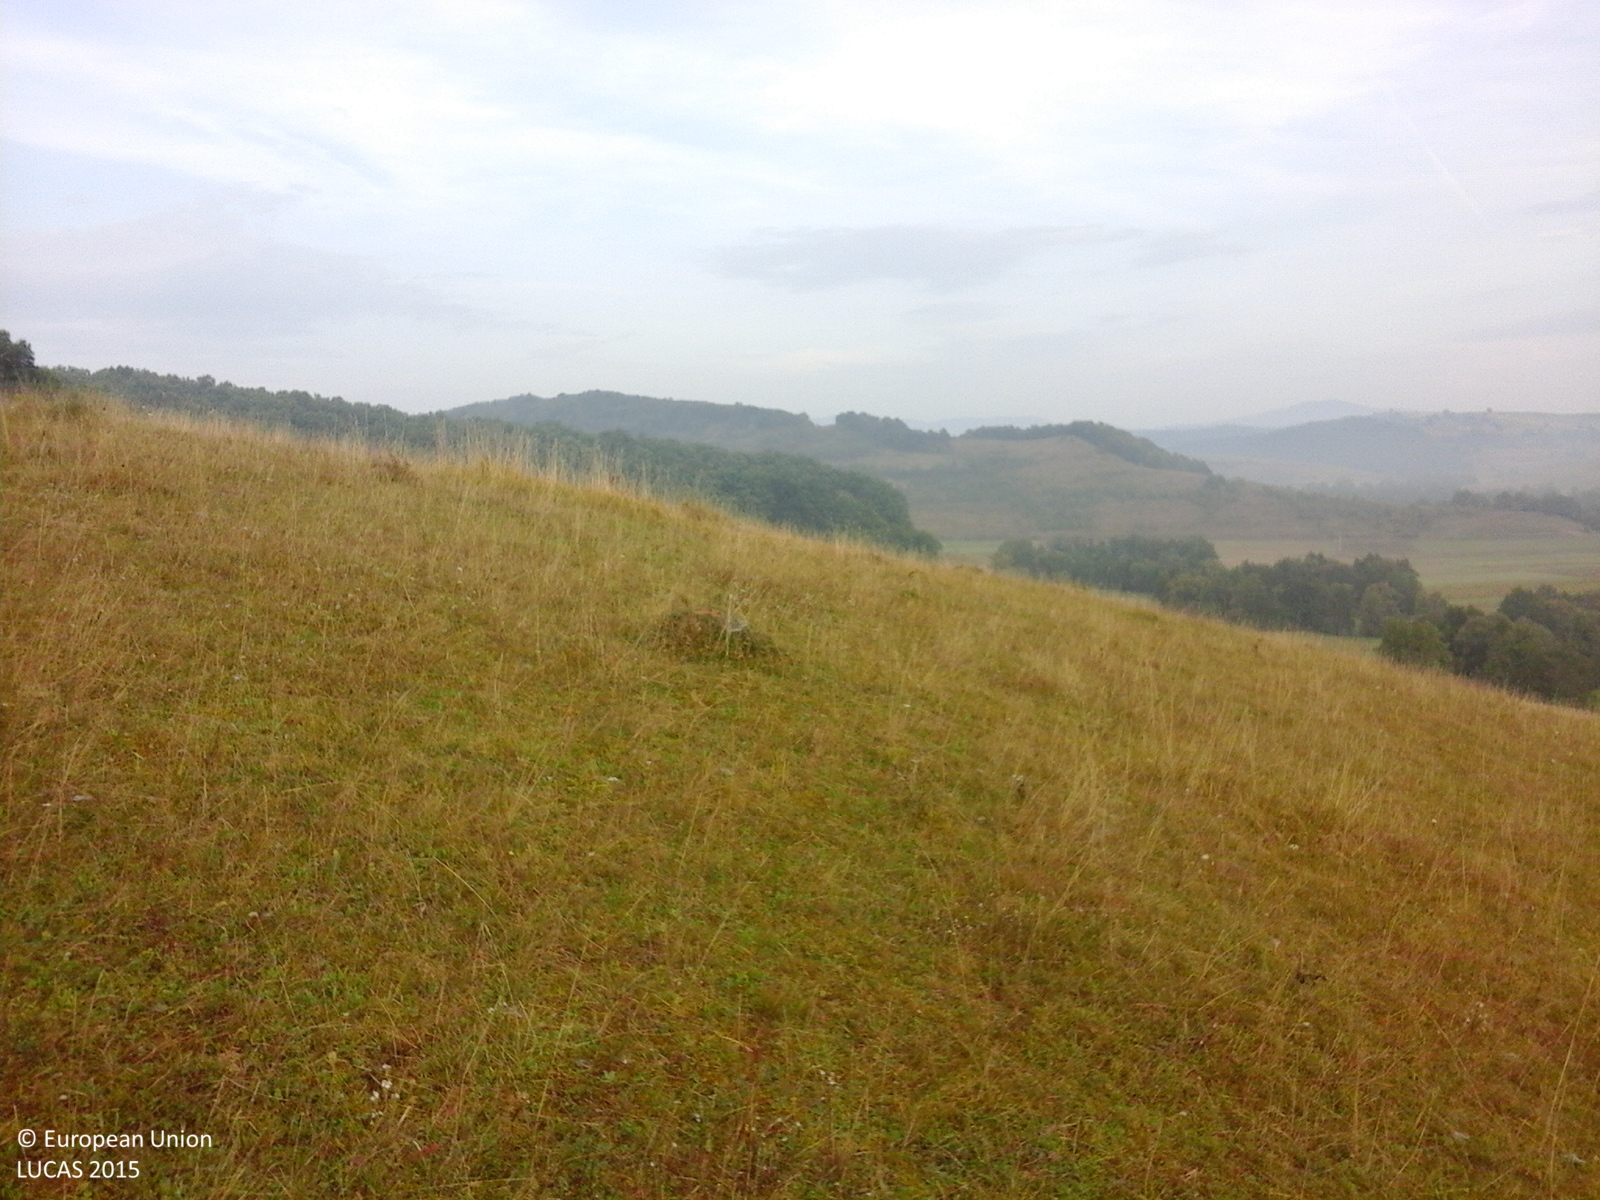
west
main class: Grassland
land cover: Grassland without tree/shrub cover
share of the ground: > 75 %
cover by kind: herbaceous plants 100 %
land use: Agriculture (excluding fallow land and kitchen gardens)
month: September
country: RO
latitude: 46.9153
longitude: 23.0485
